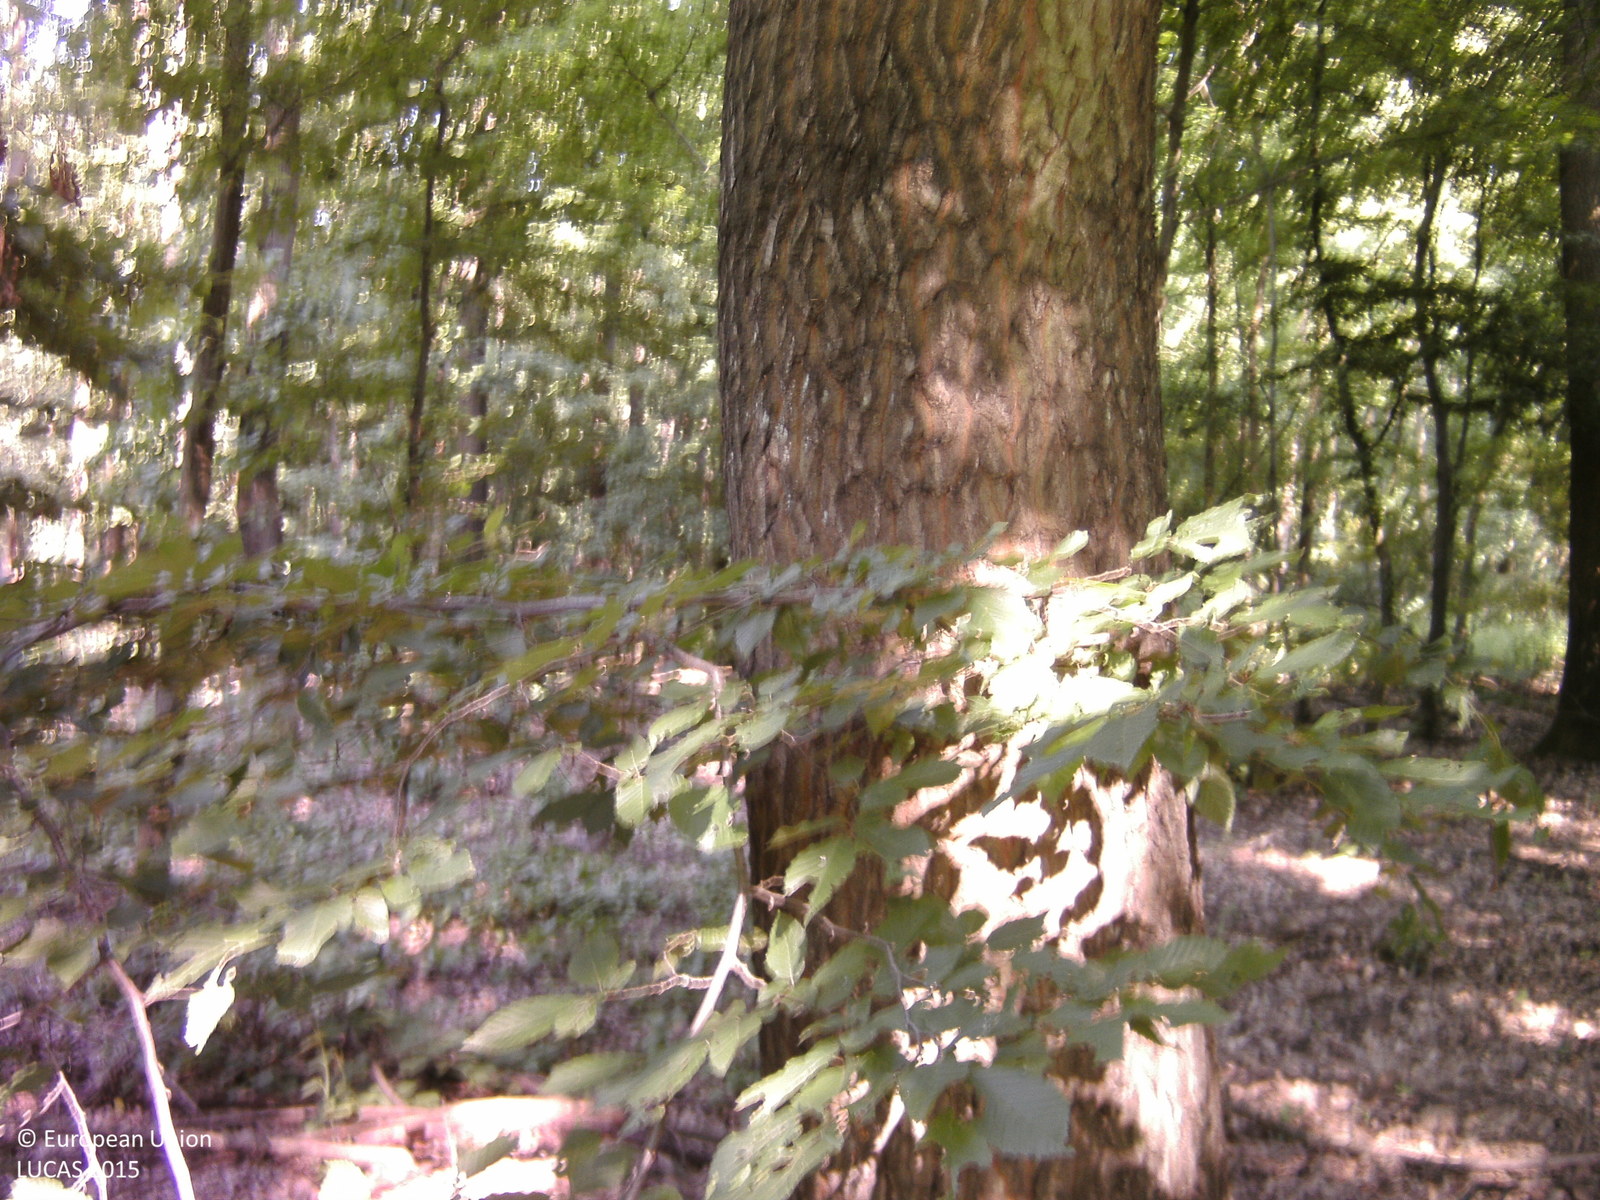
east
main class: Woodland
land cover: Broadleaved woodland
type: mesophytic deciduous forest
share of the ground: > 75 %
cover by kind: broadleaved forest trees 90 %, shrubs 5 %, herbaceous plants 5 %
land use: Forestry
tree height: > 5 m
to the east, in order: Broadleaved woodland
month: June
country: HU
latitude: 46.4420
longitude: 17.8554
